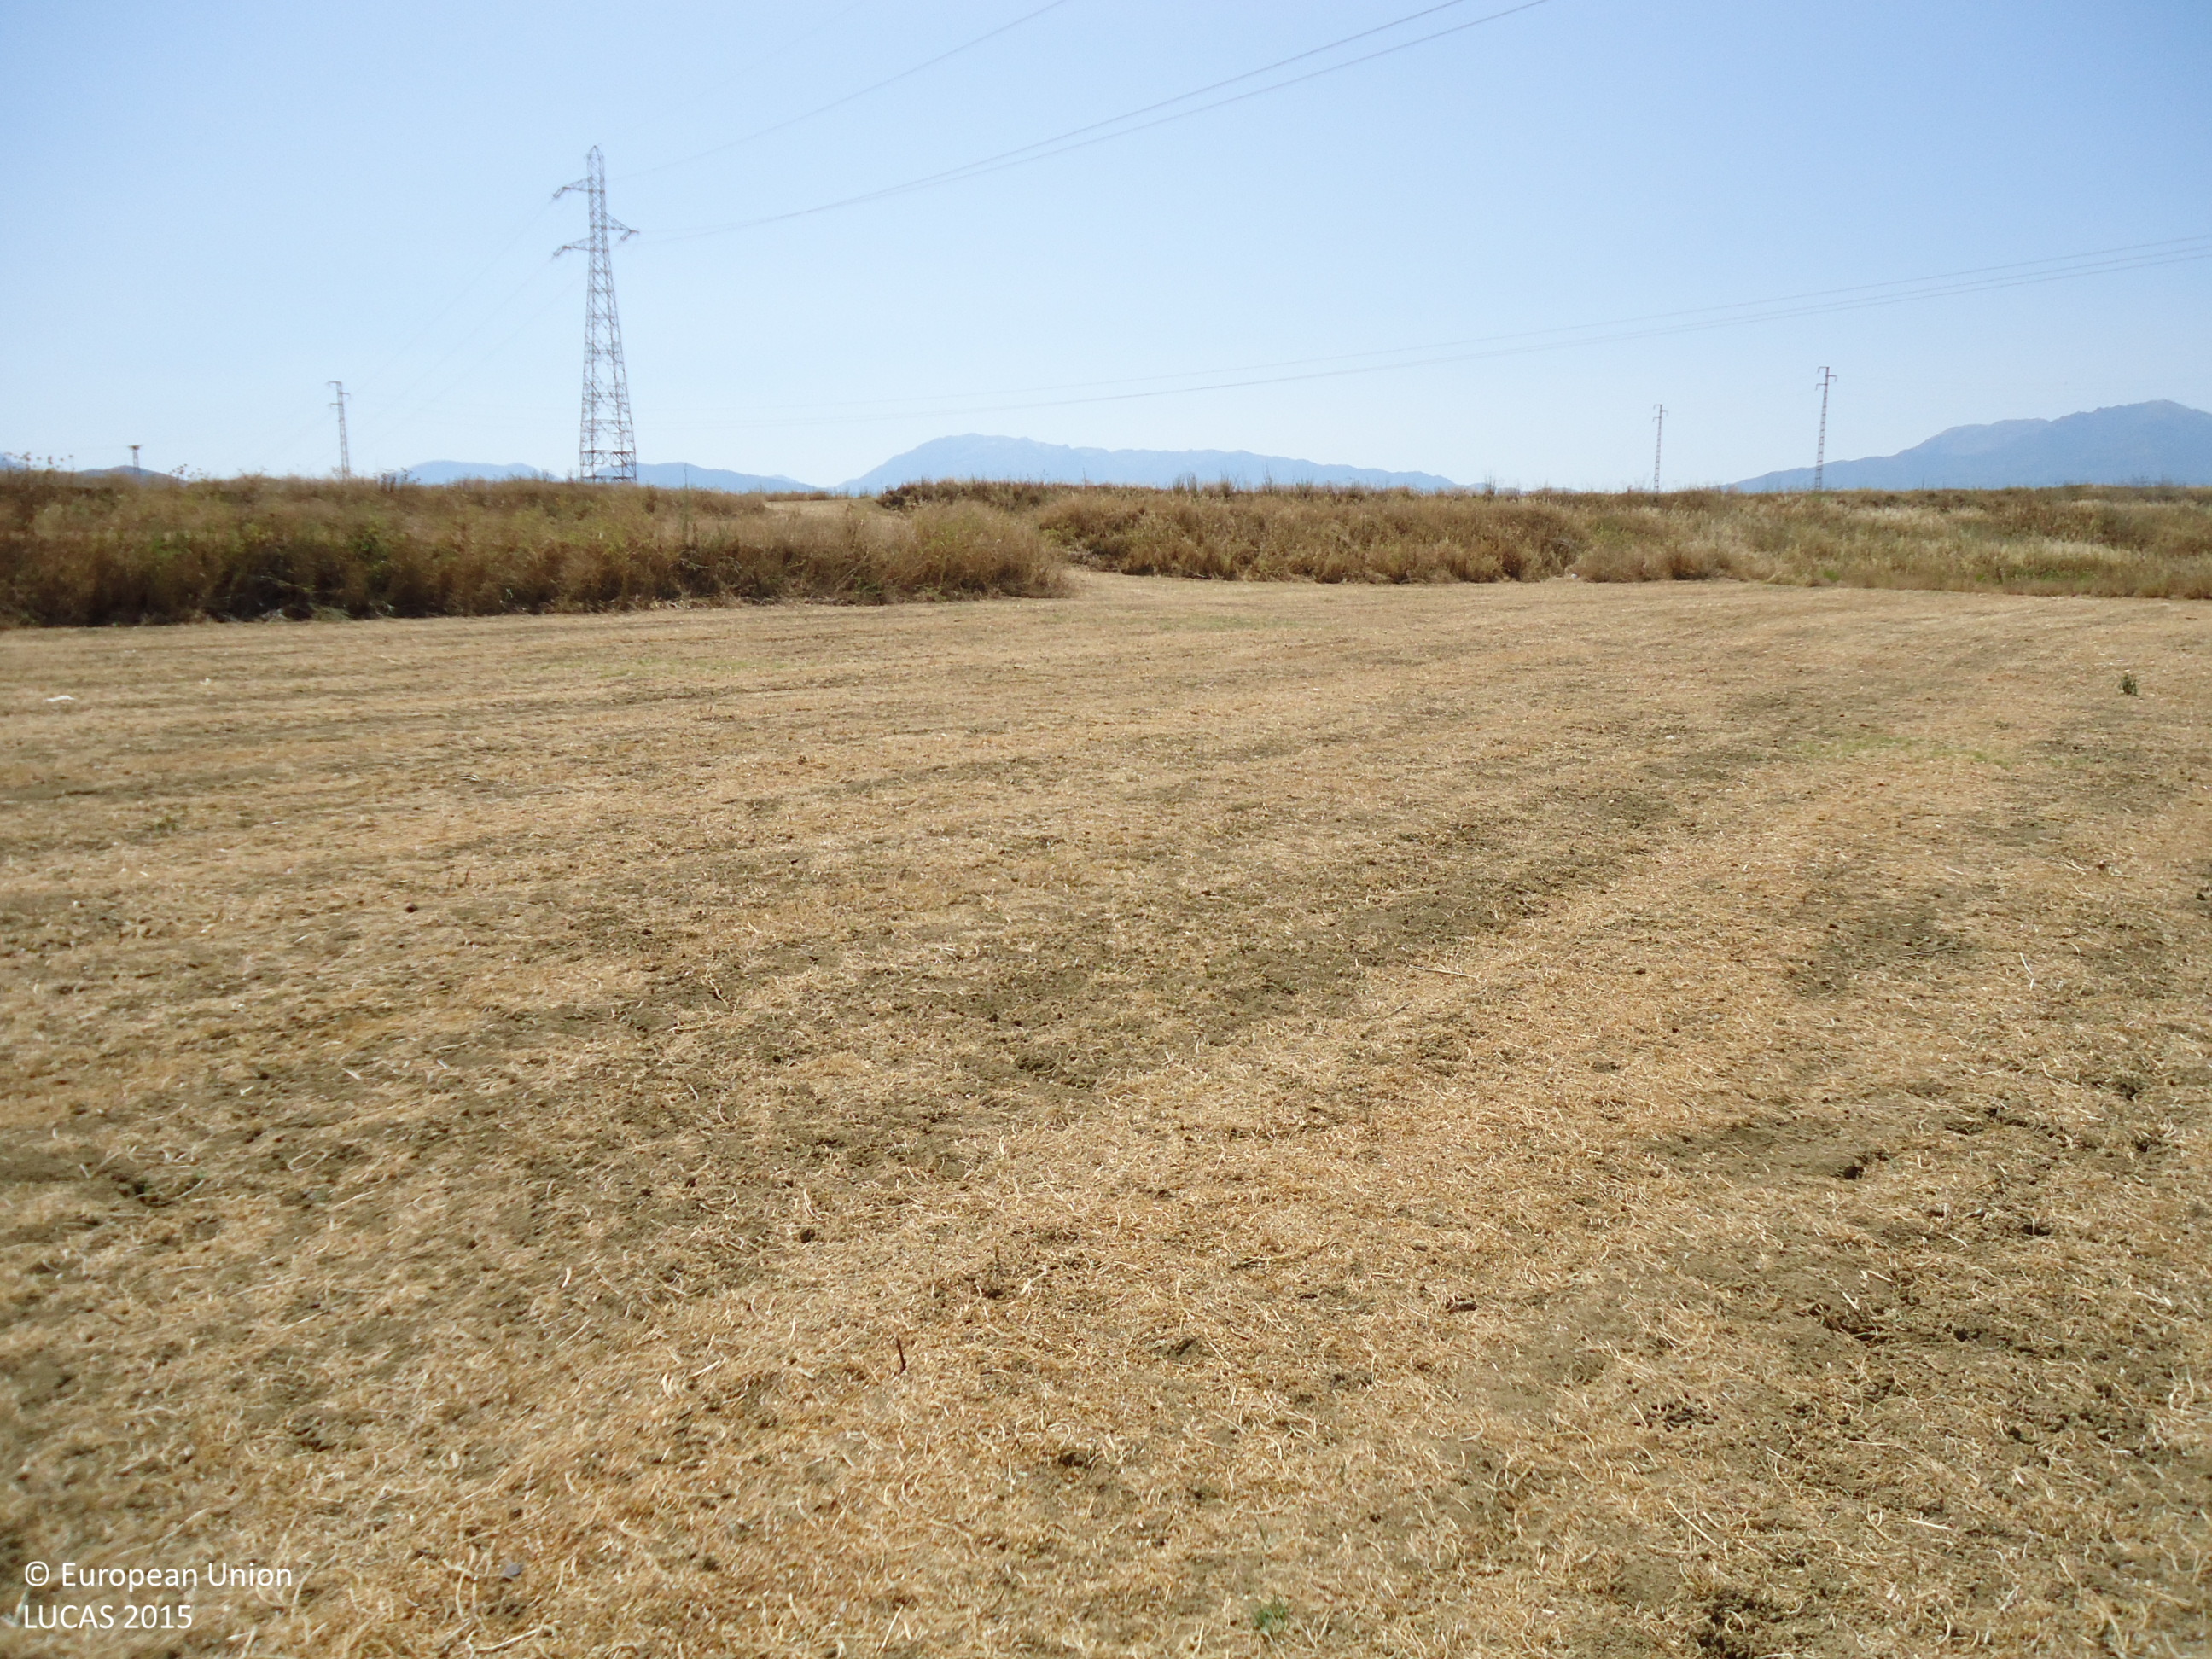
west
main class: Grassland
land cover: Spontaneously vegetated surfaces
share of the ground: > 75 %
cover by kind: herbaceous plants 90 %, unconsolidated bare surface 10 %
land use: Agriculture (excluding fallow land and kitchen gardens)
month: June
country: ES
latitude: 36.6854
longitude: -4.7314
